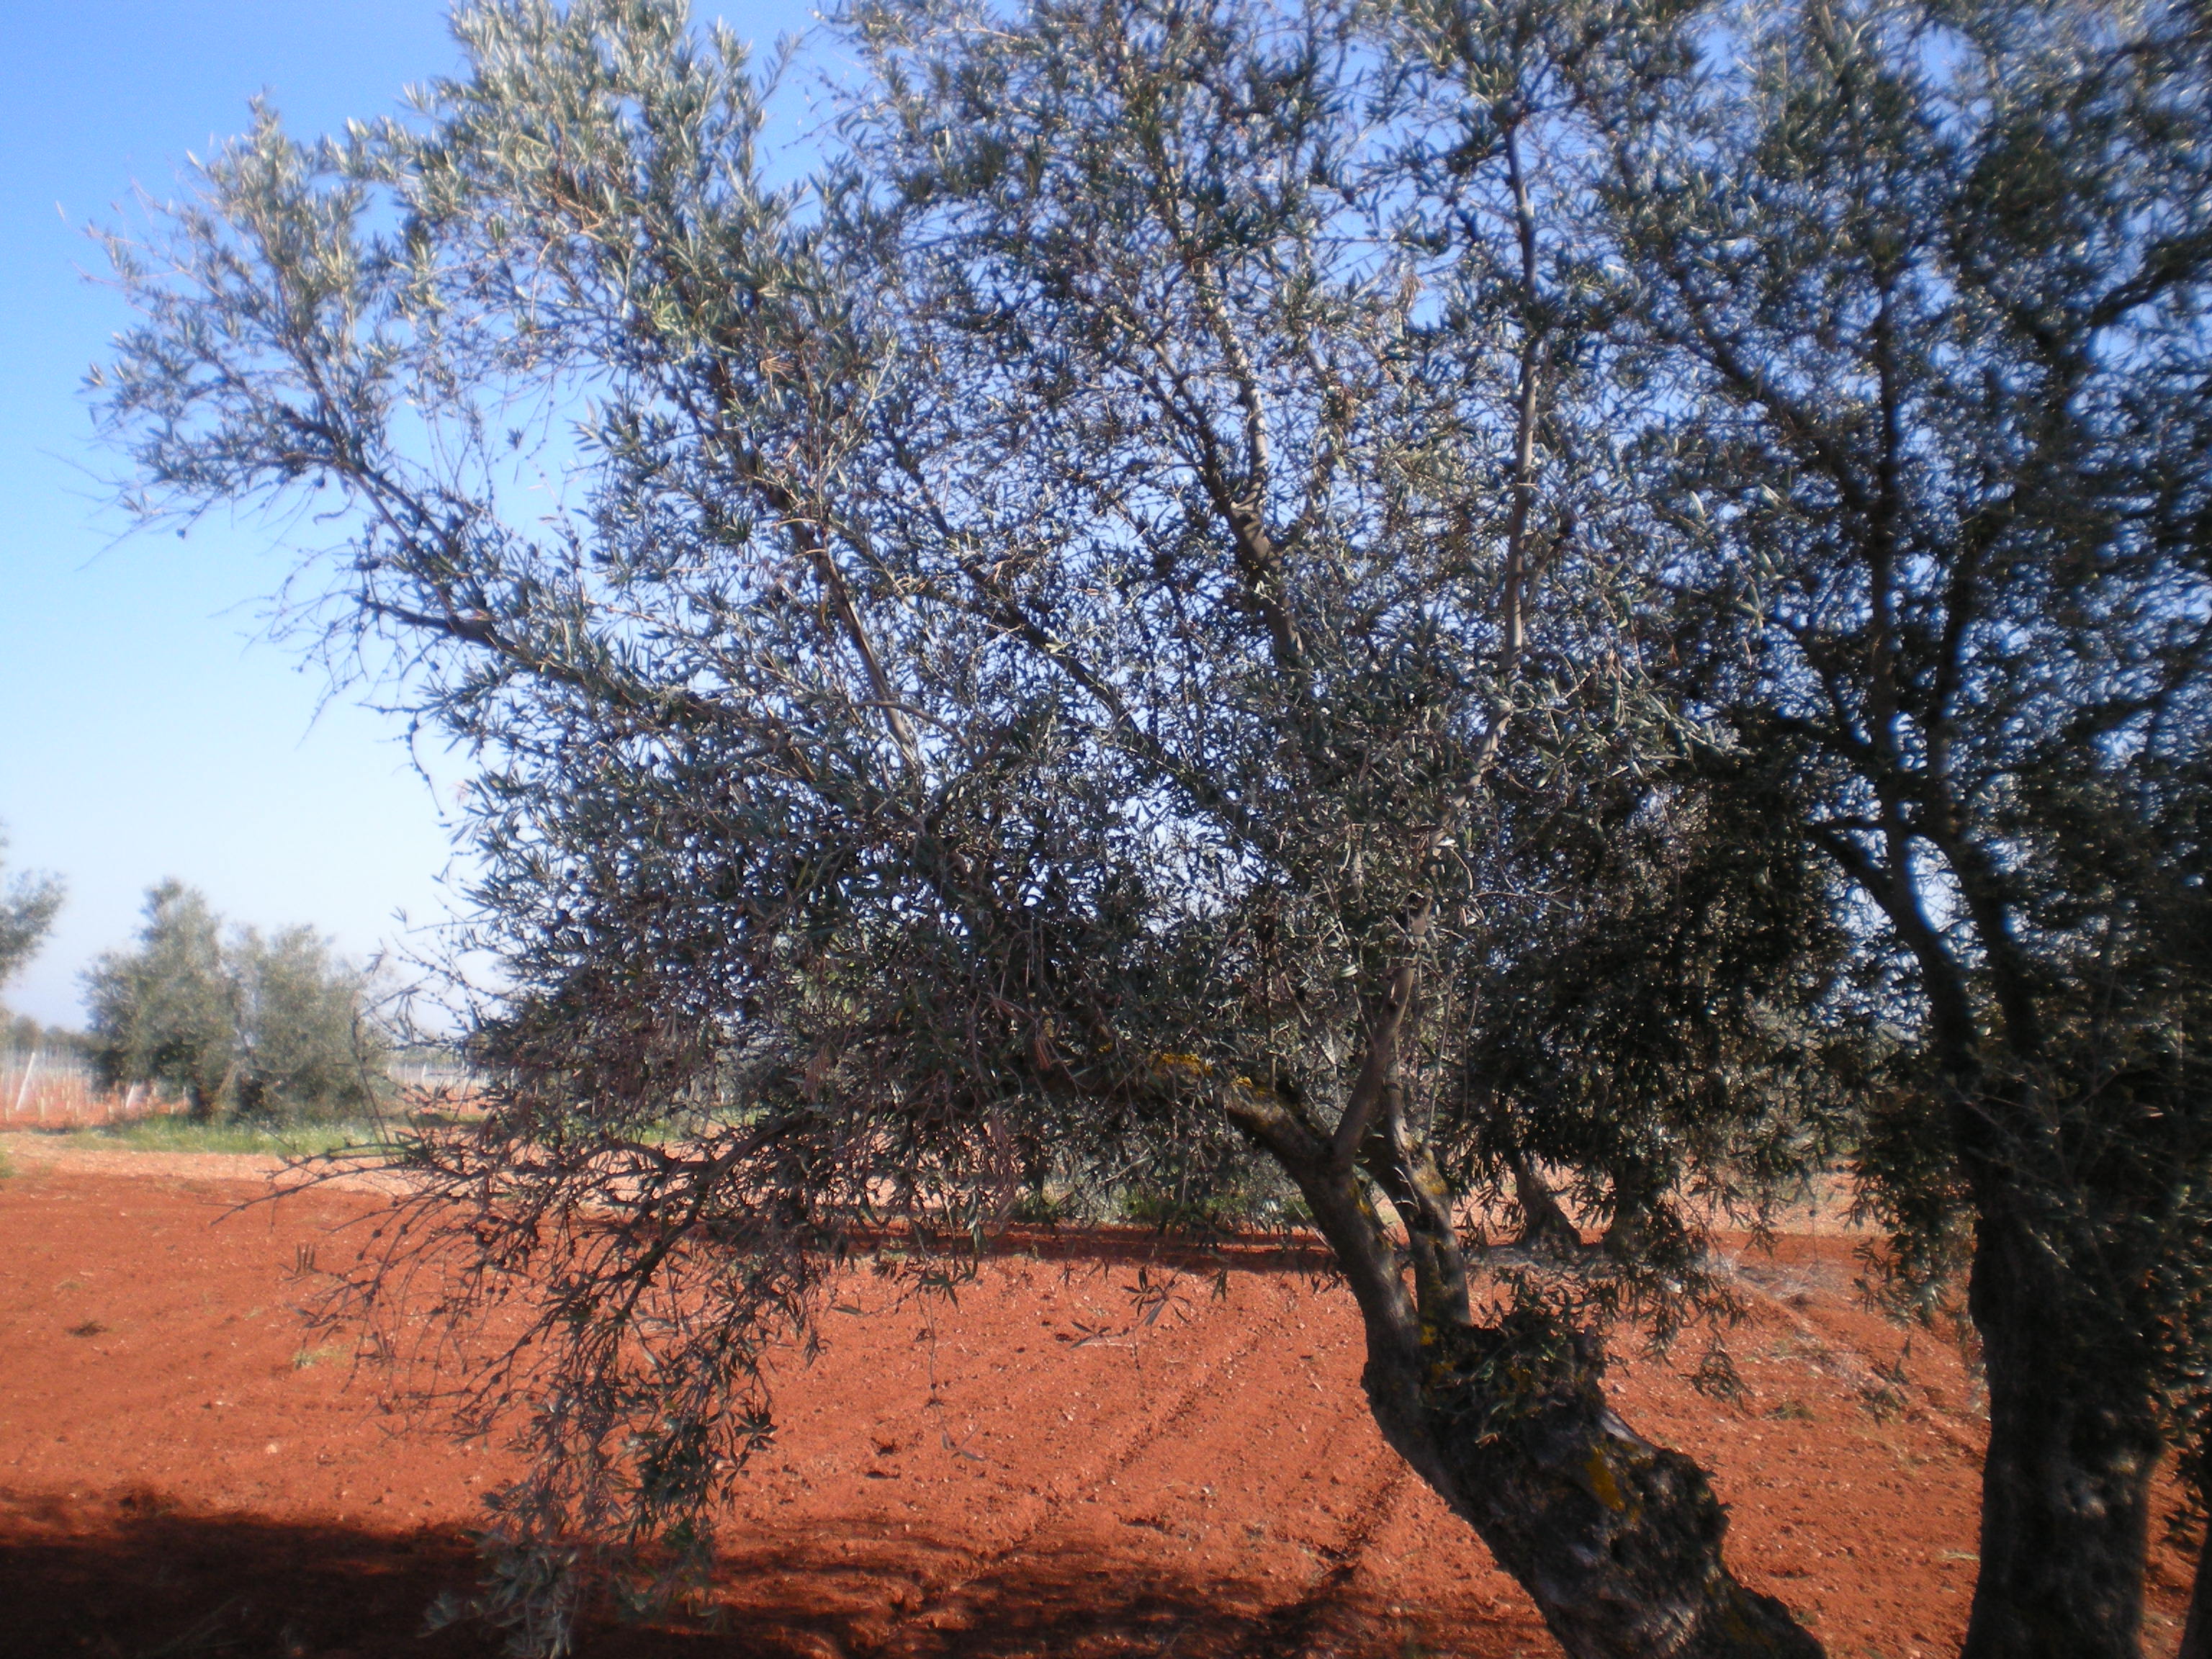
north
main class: Cropland
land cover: Olive groves
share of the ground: 10 - 25 %
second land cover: Other bare soil
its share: > 75 %
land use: Agriculture (excluding fallow land and kitchen gardens)
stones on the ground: < 10 %
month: April
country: ES
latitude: 38.9105
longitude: -3.6121
